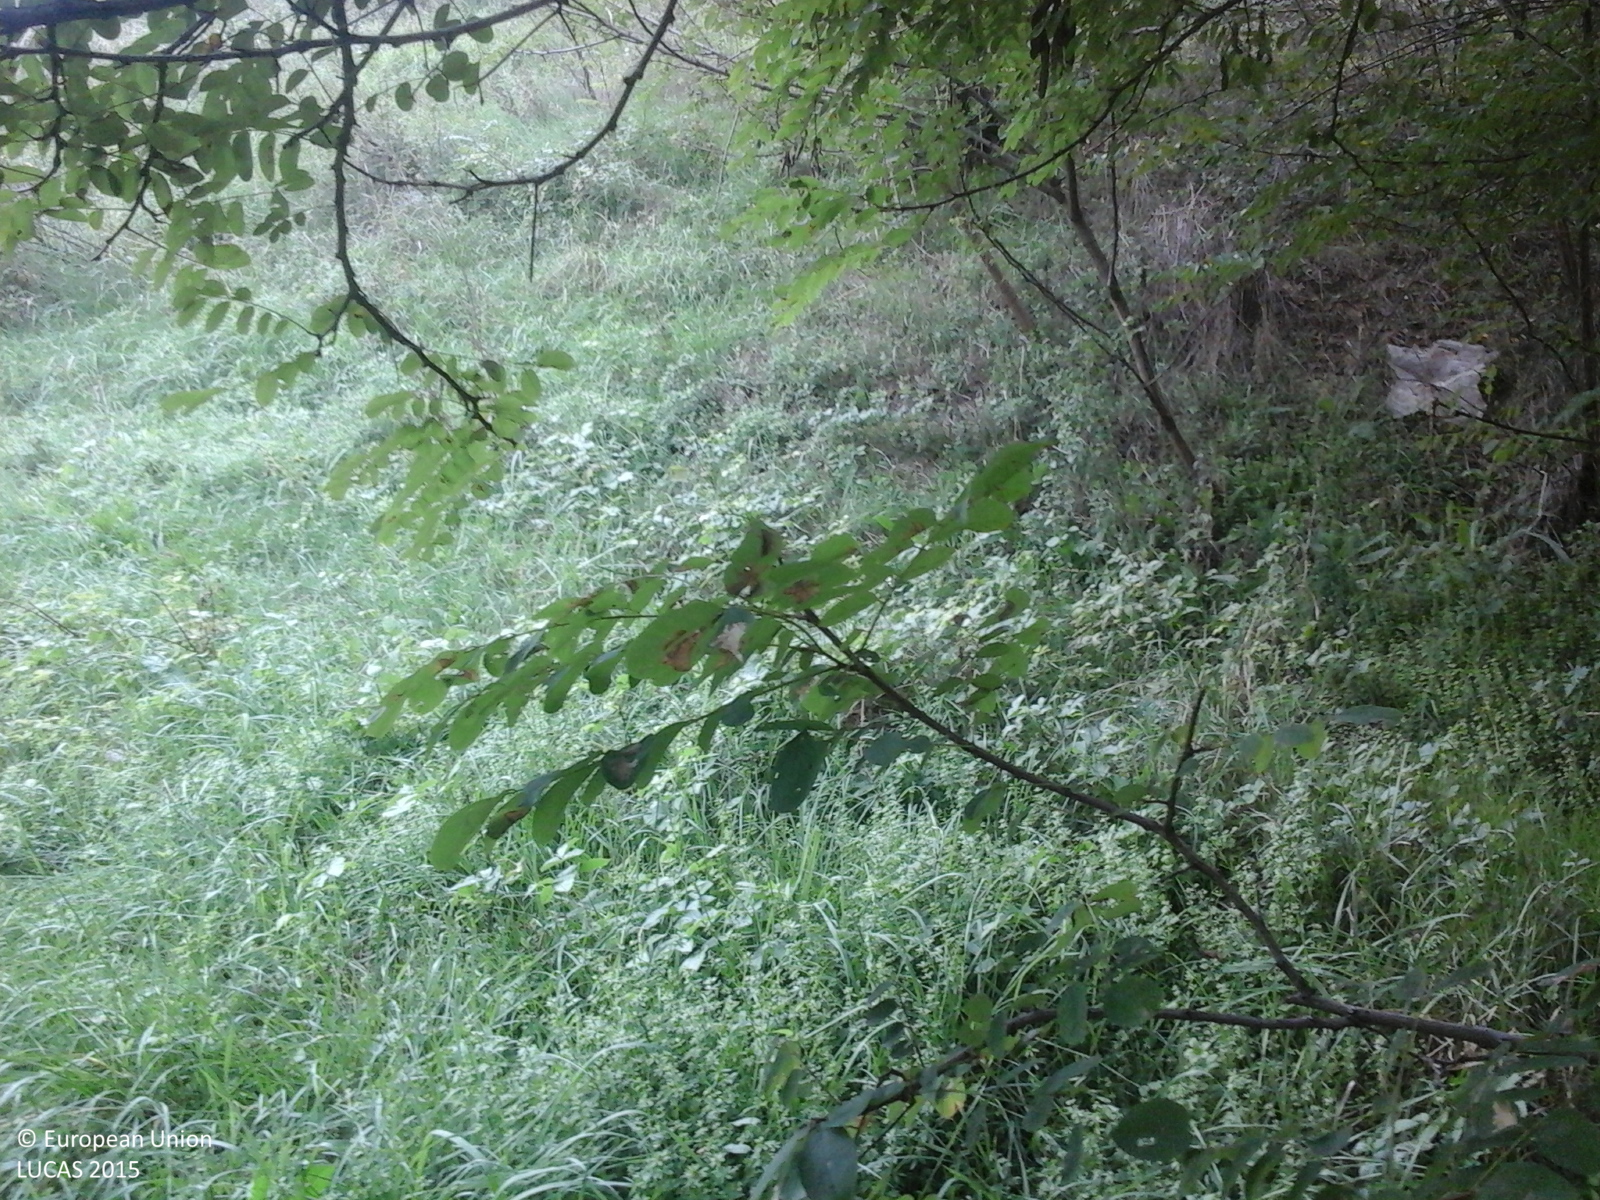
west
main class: Woodland
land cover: Broadleaved woodland
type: exotic forest
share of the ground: > 75 %
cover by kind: broadleaved forest trees 100 %
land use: Forestry
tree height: > 5 m
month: September
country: RO
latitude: 44.8844
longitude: 23.1029
